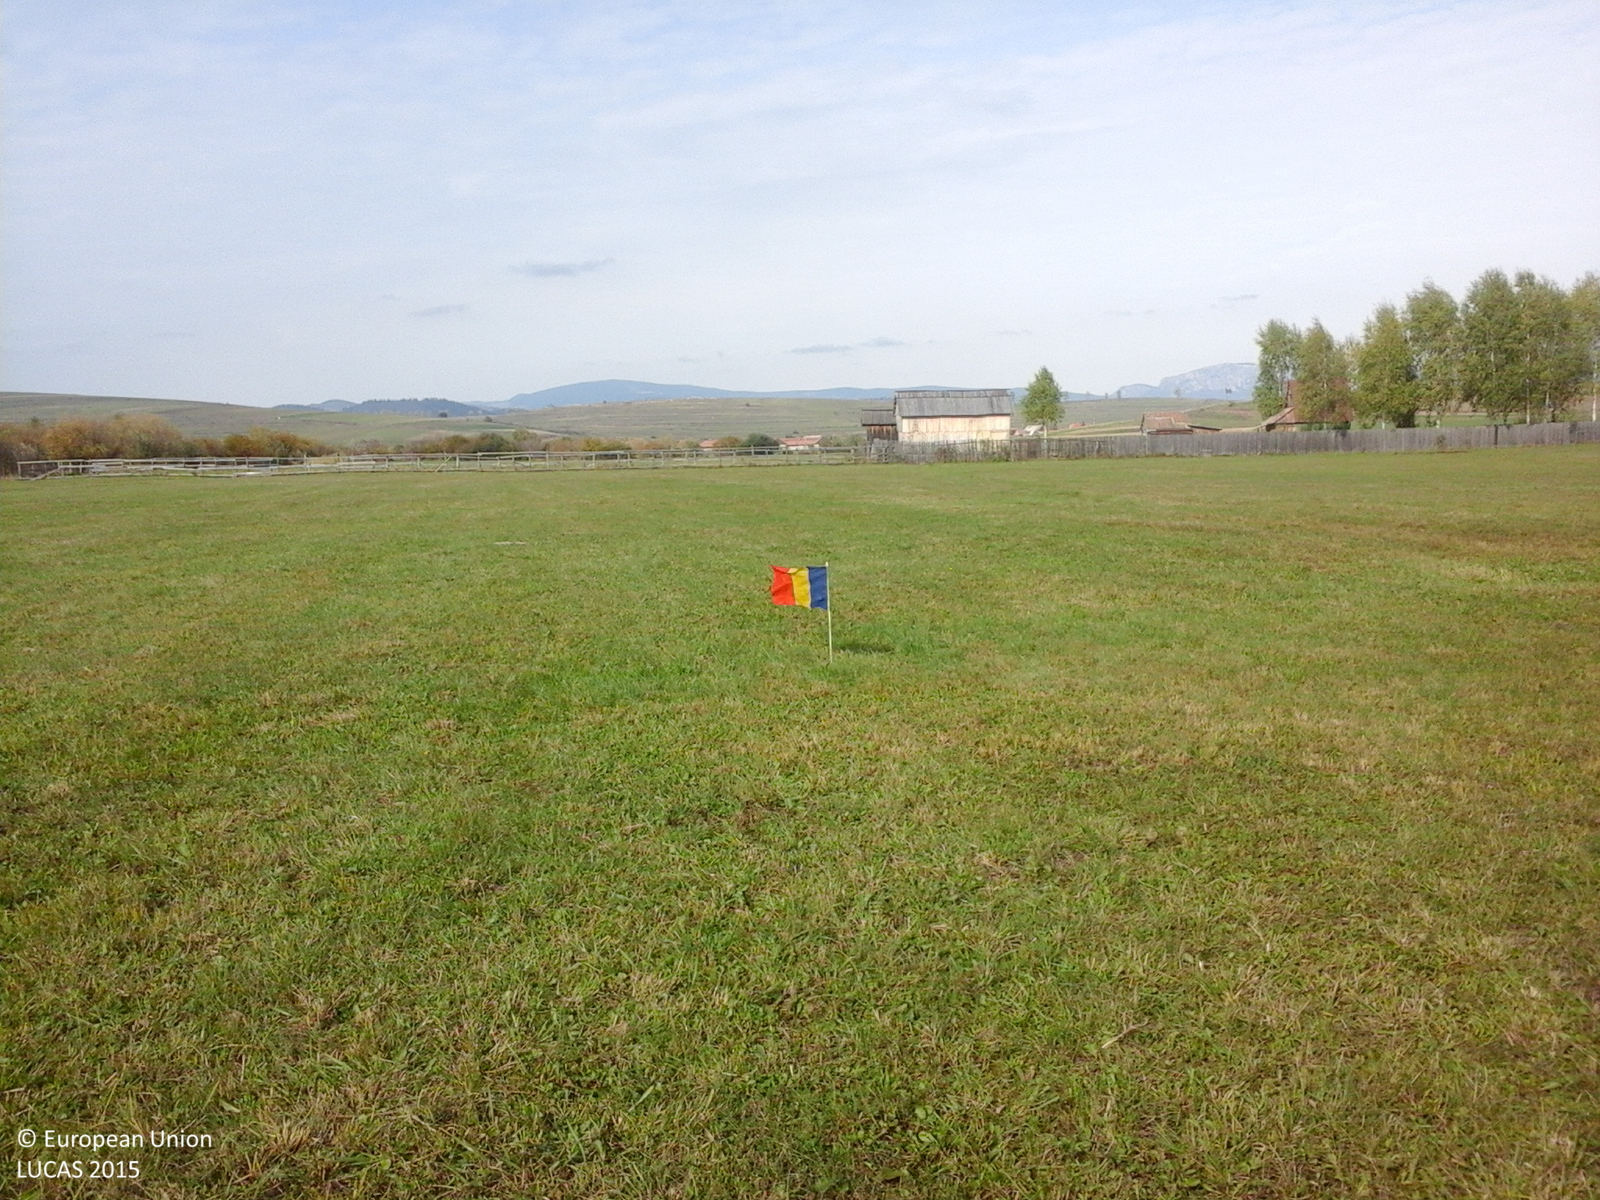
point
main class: Grassland
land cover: Grassland without tree/shrub cover
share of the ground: > 75 %
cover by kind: herbaceous plants 100 %
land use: Agriculture (excluding fallow land and kitchen gardens)
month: October
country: RO
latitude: 46.5148
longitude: 25.7423
